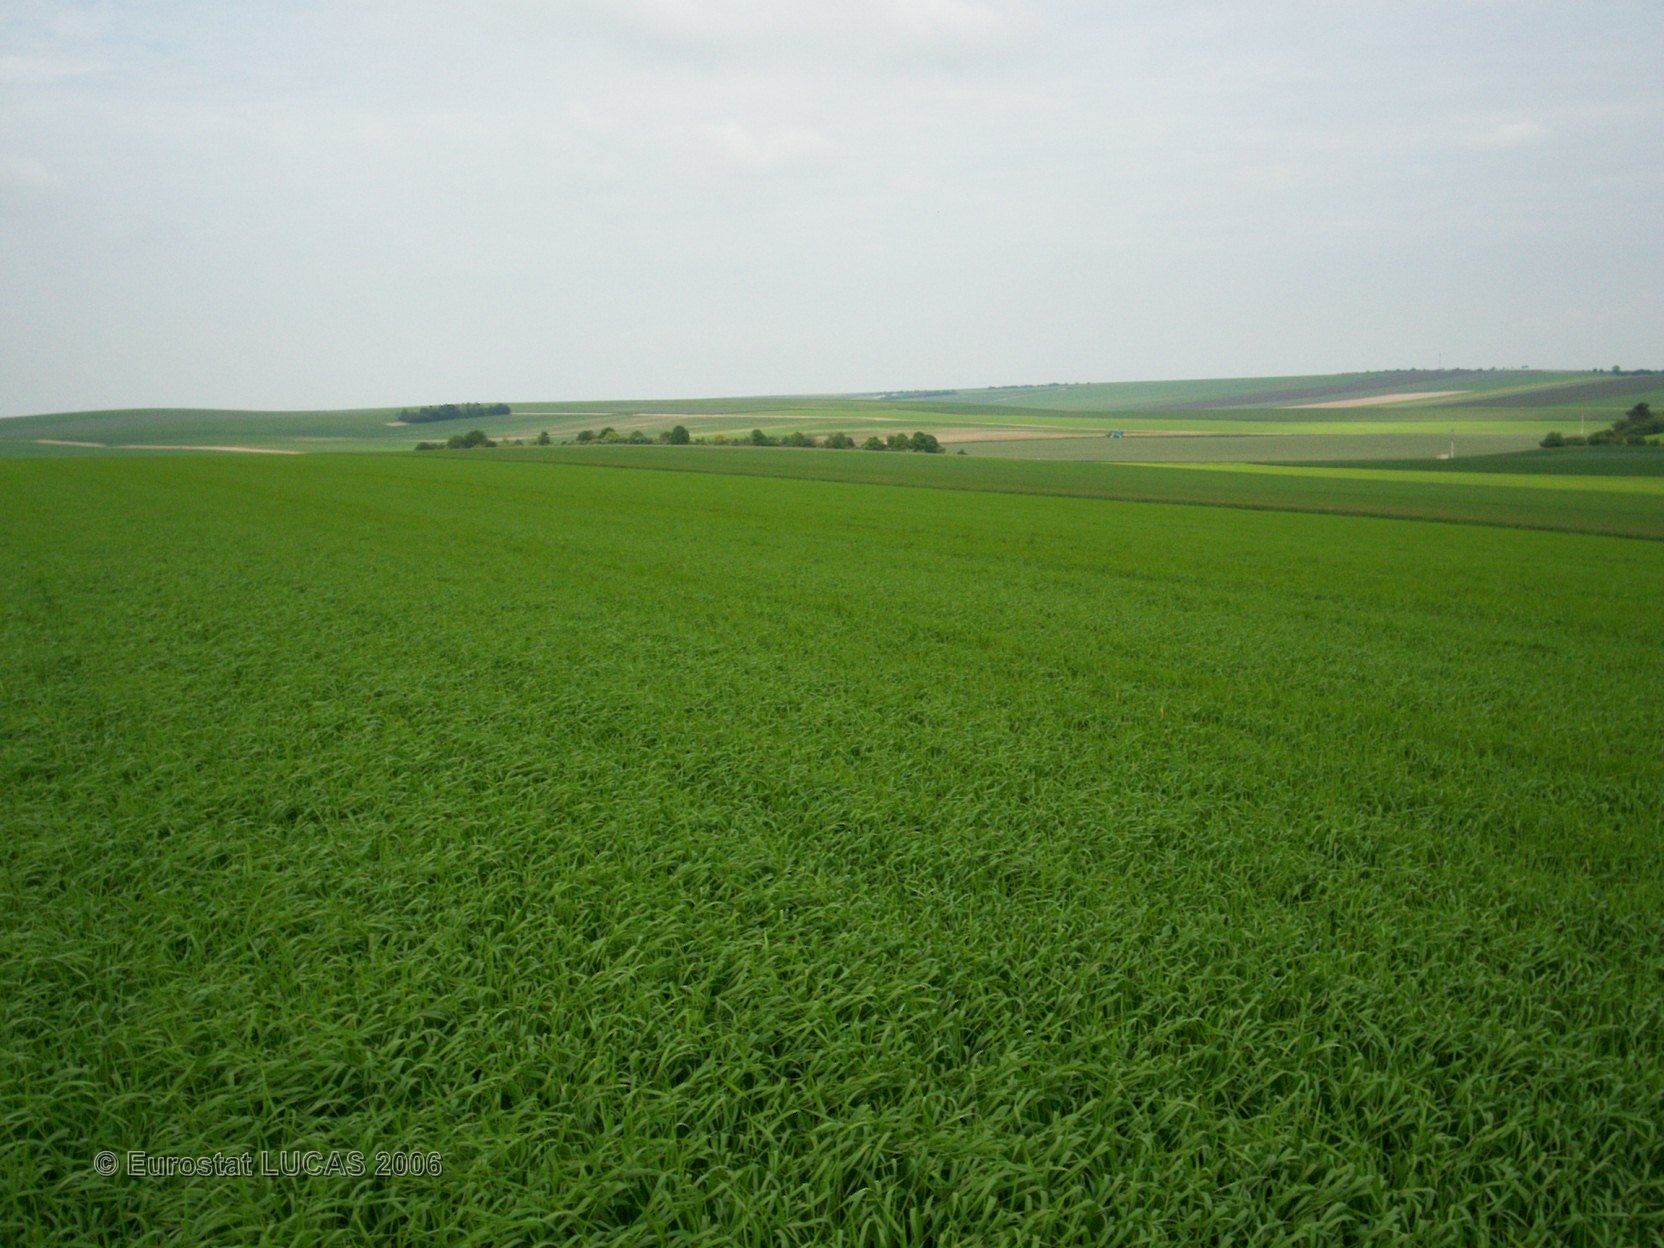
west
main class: Cropland
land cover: Barley
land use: Agriculture (excluding fallow land and kitchen gardens)
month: June
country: FR
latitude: 48.7309
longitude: 4.4089
